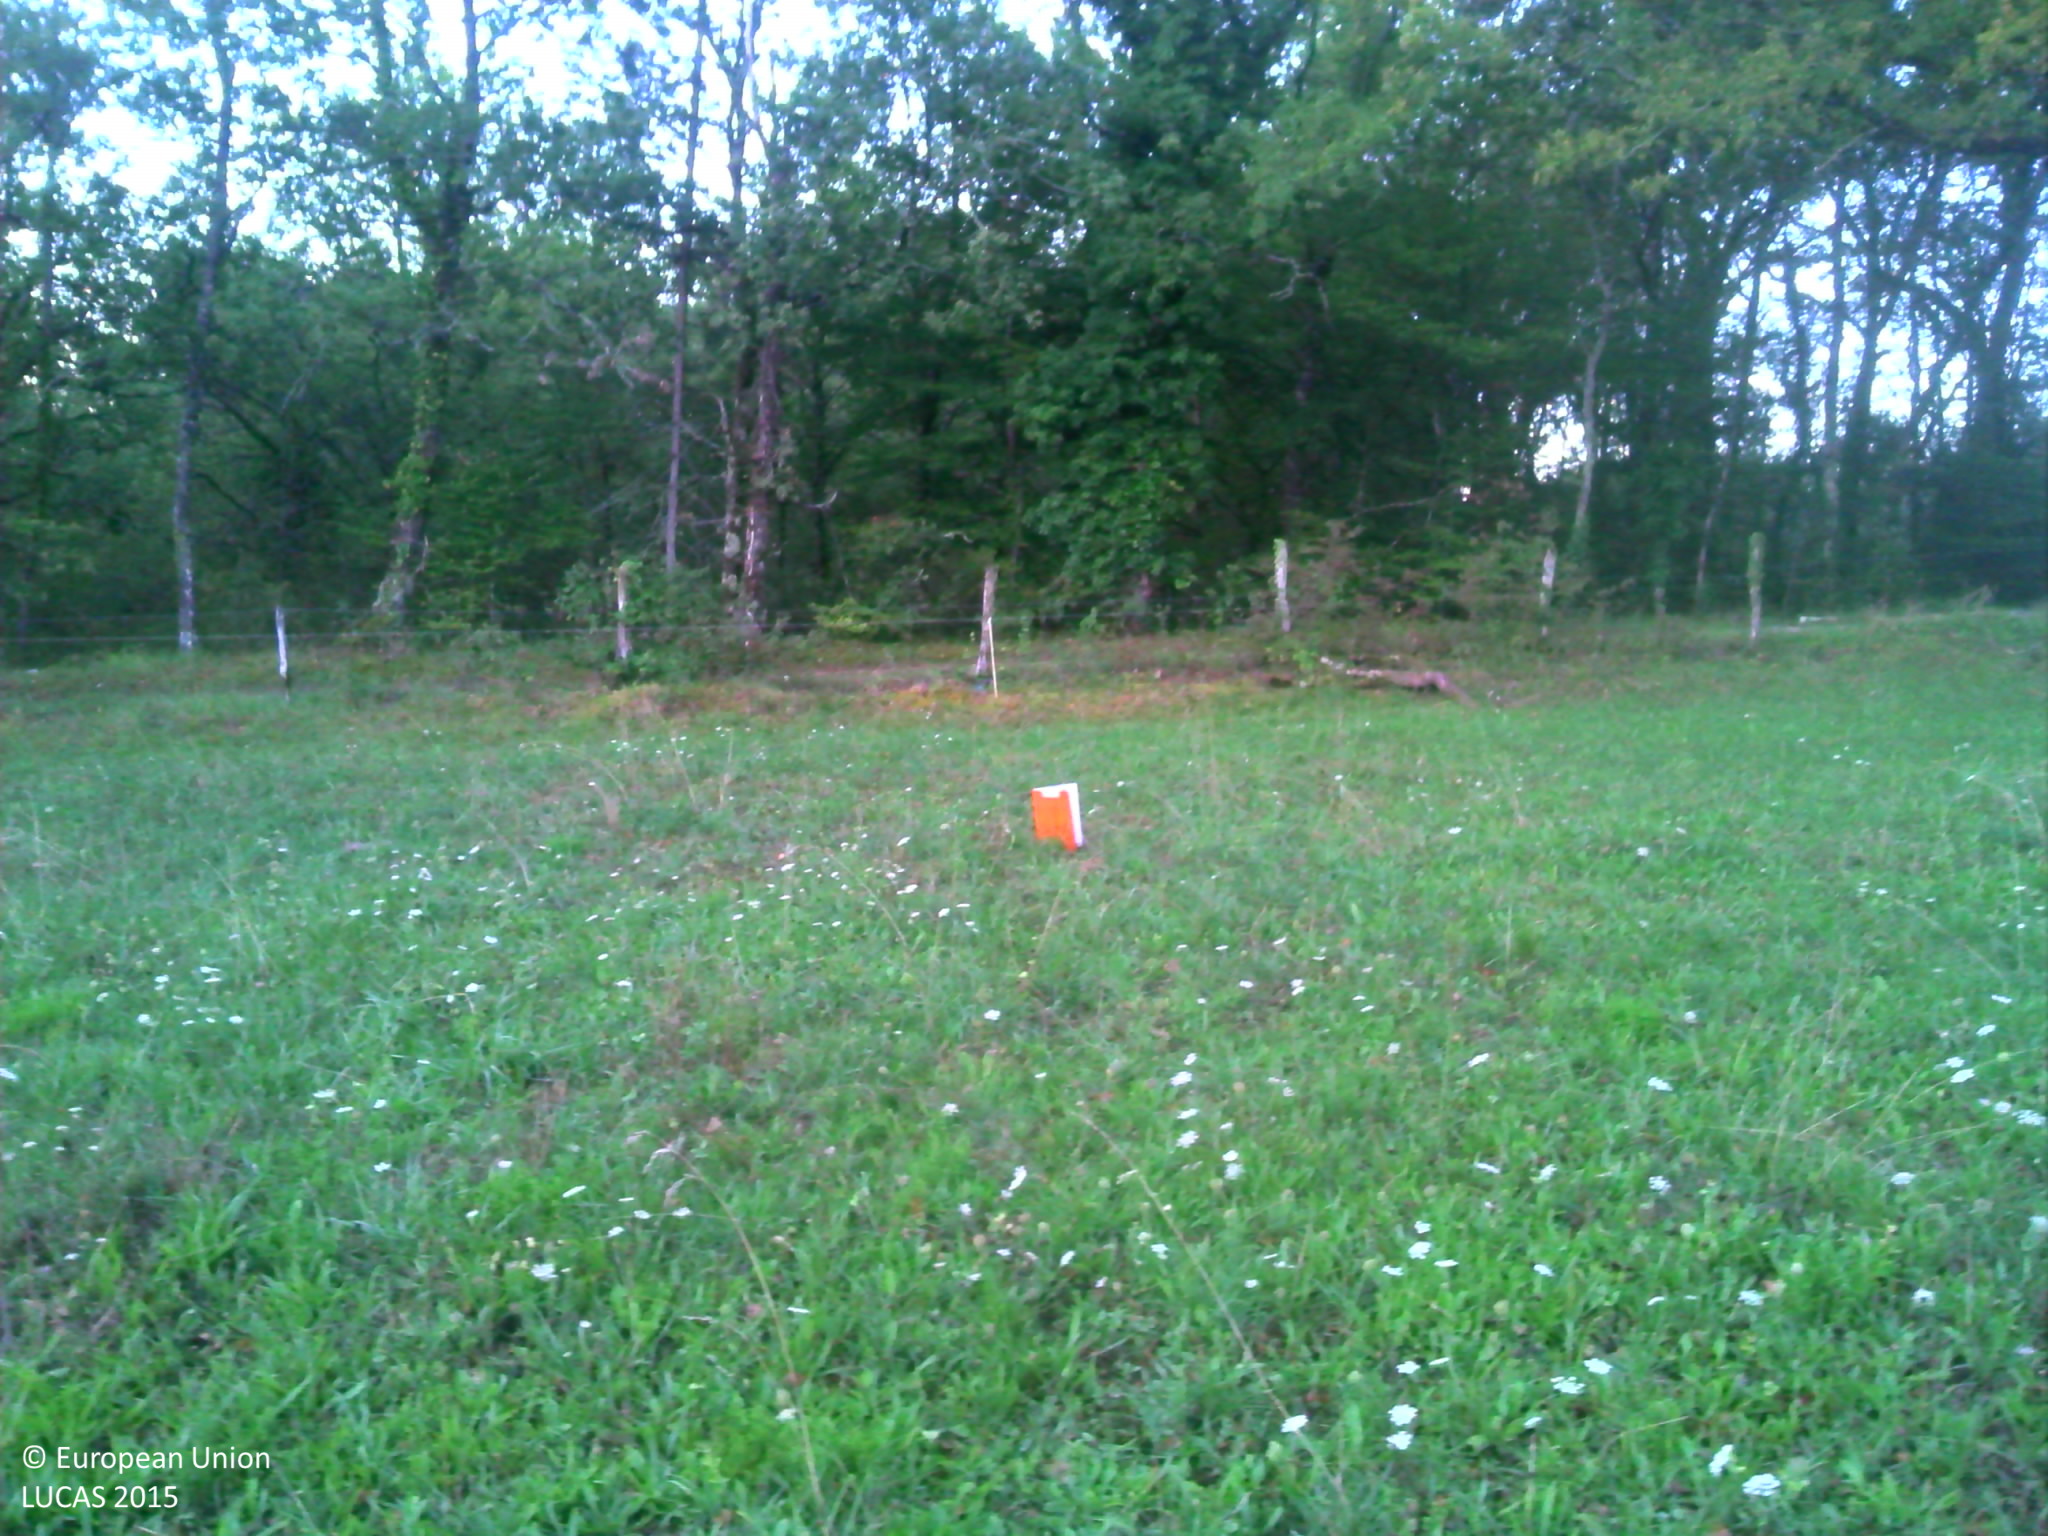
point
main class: Grassland
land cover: Grassland without tree/shrub cover
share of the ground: > 75 %
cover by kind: herbaceous plants 100 %
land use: Agriculture (excluding fallow land and kitchen gardens)
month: August
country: FR
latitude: 44.8137
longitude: 1.4611
